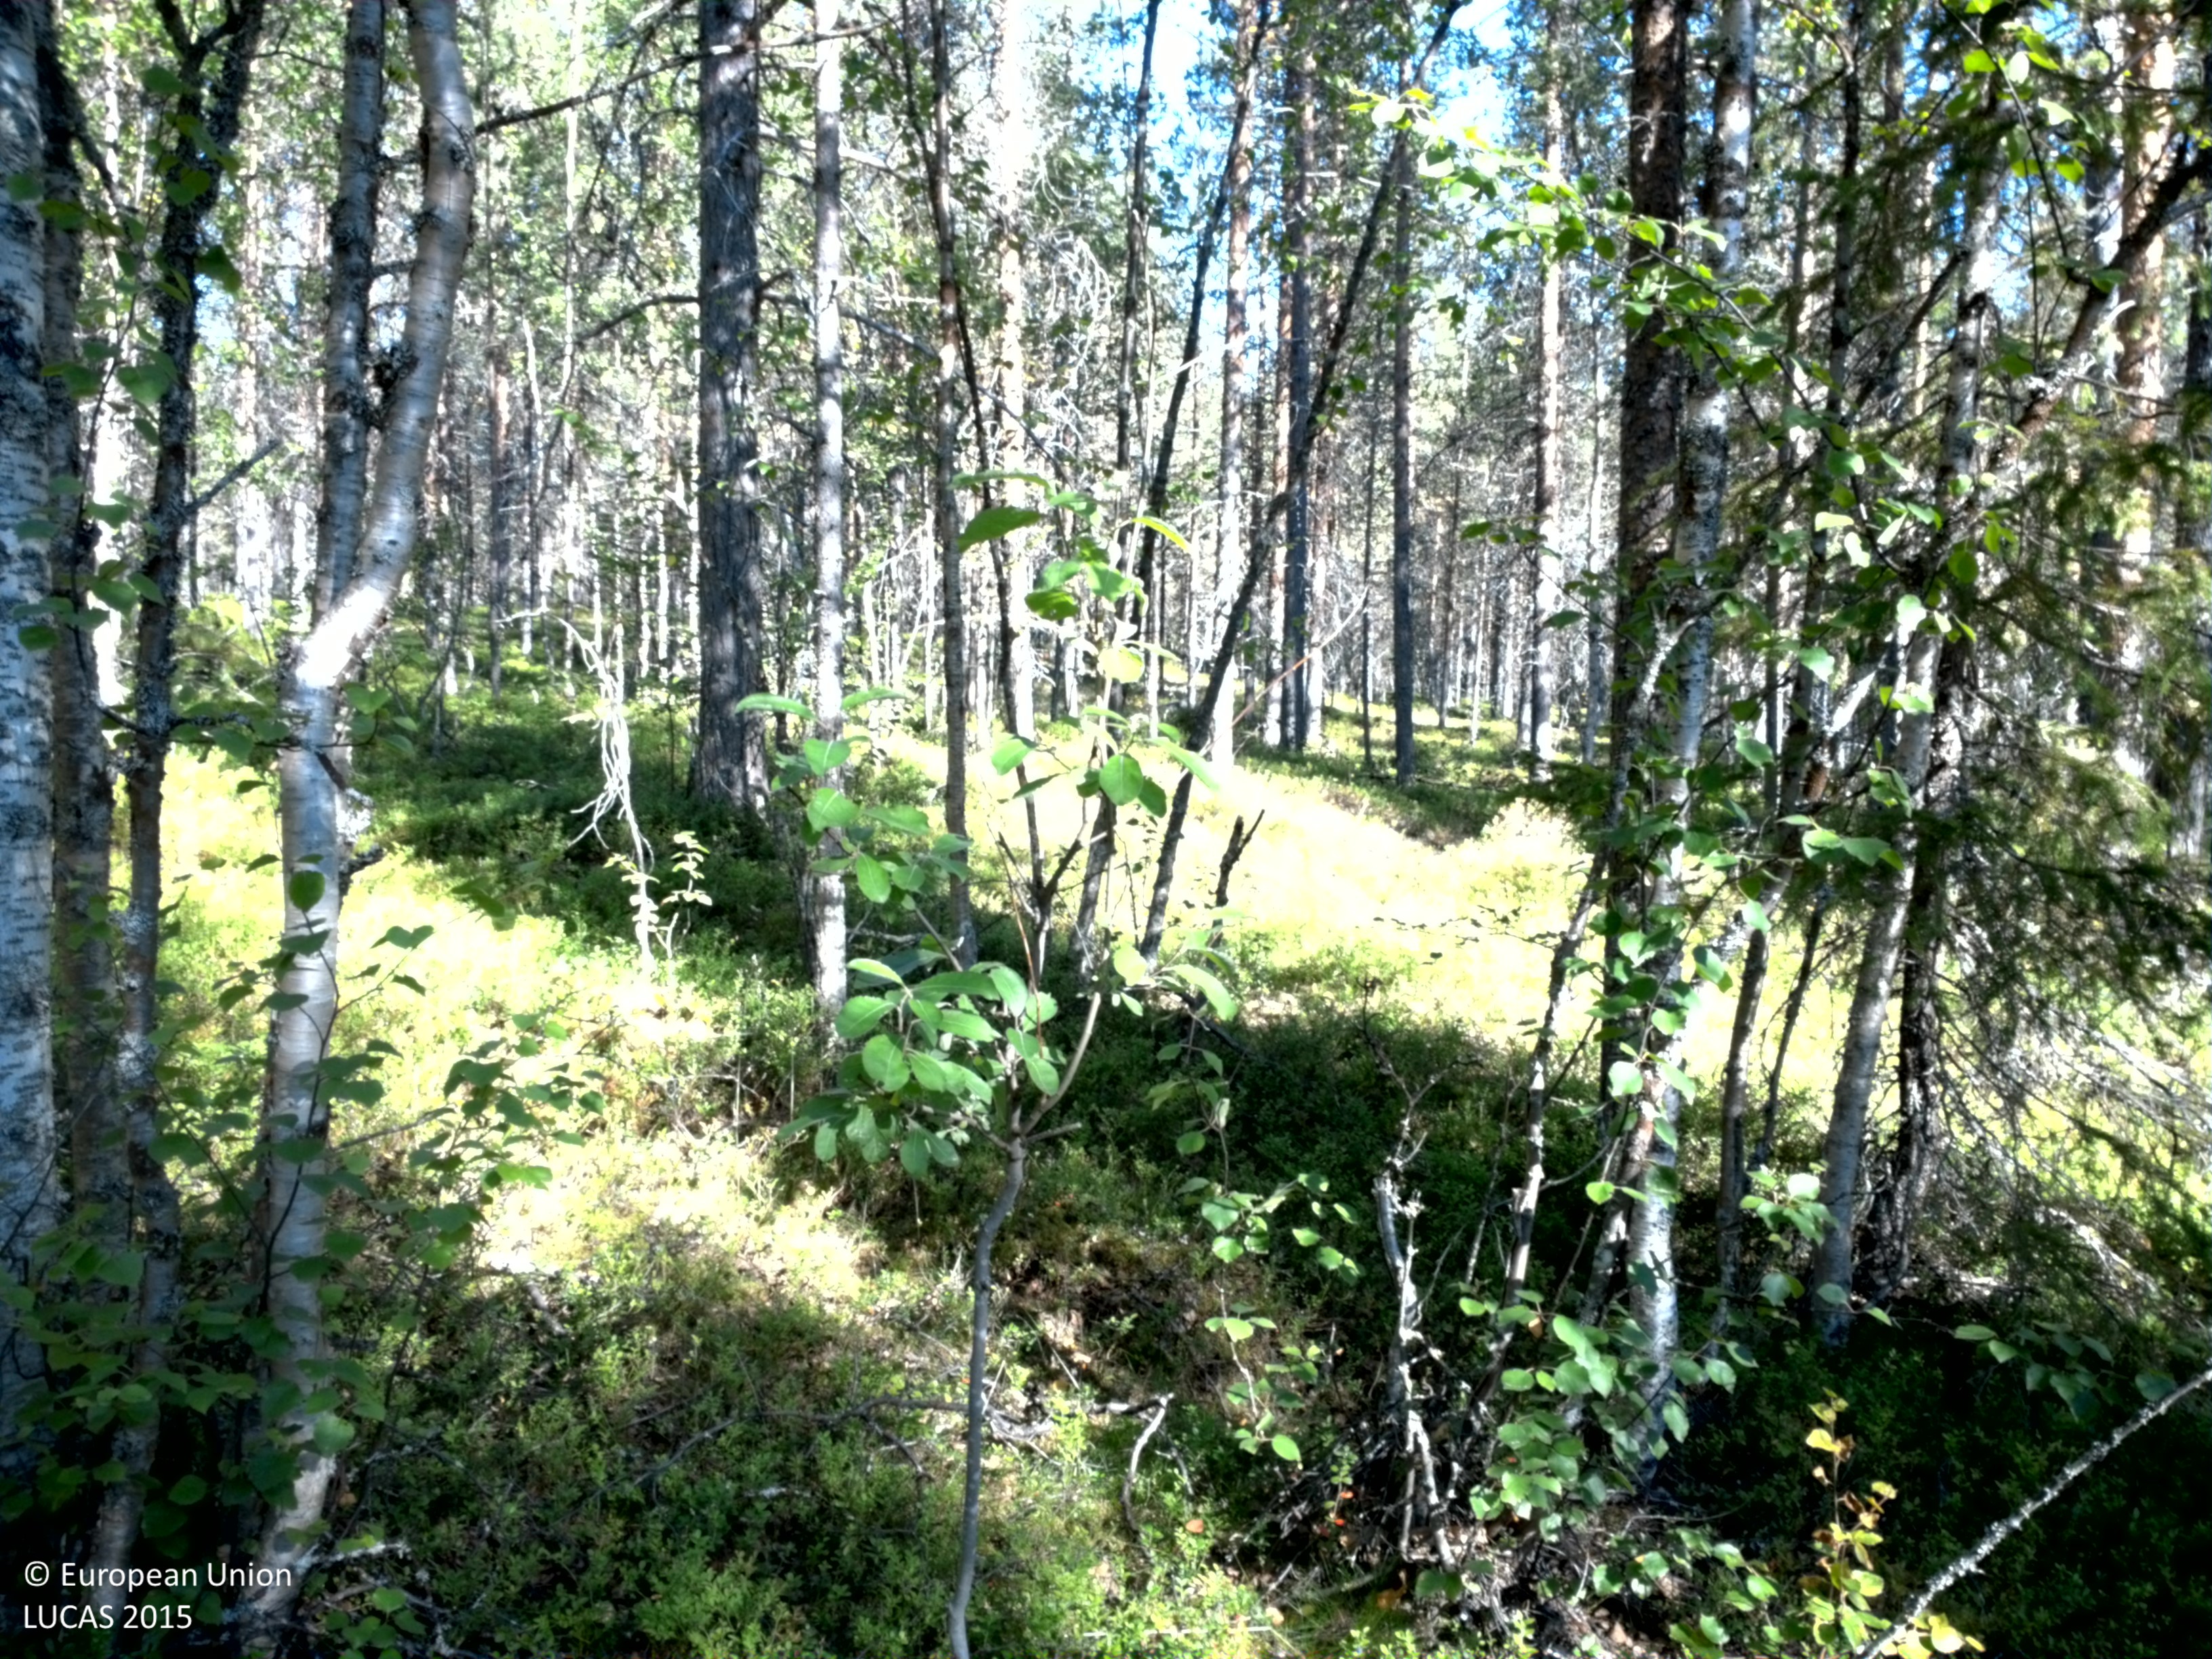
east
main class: Woodland
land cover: Pine dominated coniferous woodland
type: boreal forest
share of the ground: 25 - 50 %
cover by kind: shrubs 60 %, coniferous forest trees 40 %
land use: Forestry
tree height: > 5 m
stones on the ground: 10 - 25 %
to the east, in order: Pine dominated coniferous woodland; Broadleaved woodland; Pine dominated coniferous woodland
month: August
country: SE
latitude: 66.6241
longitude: 18.9170
